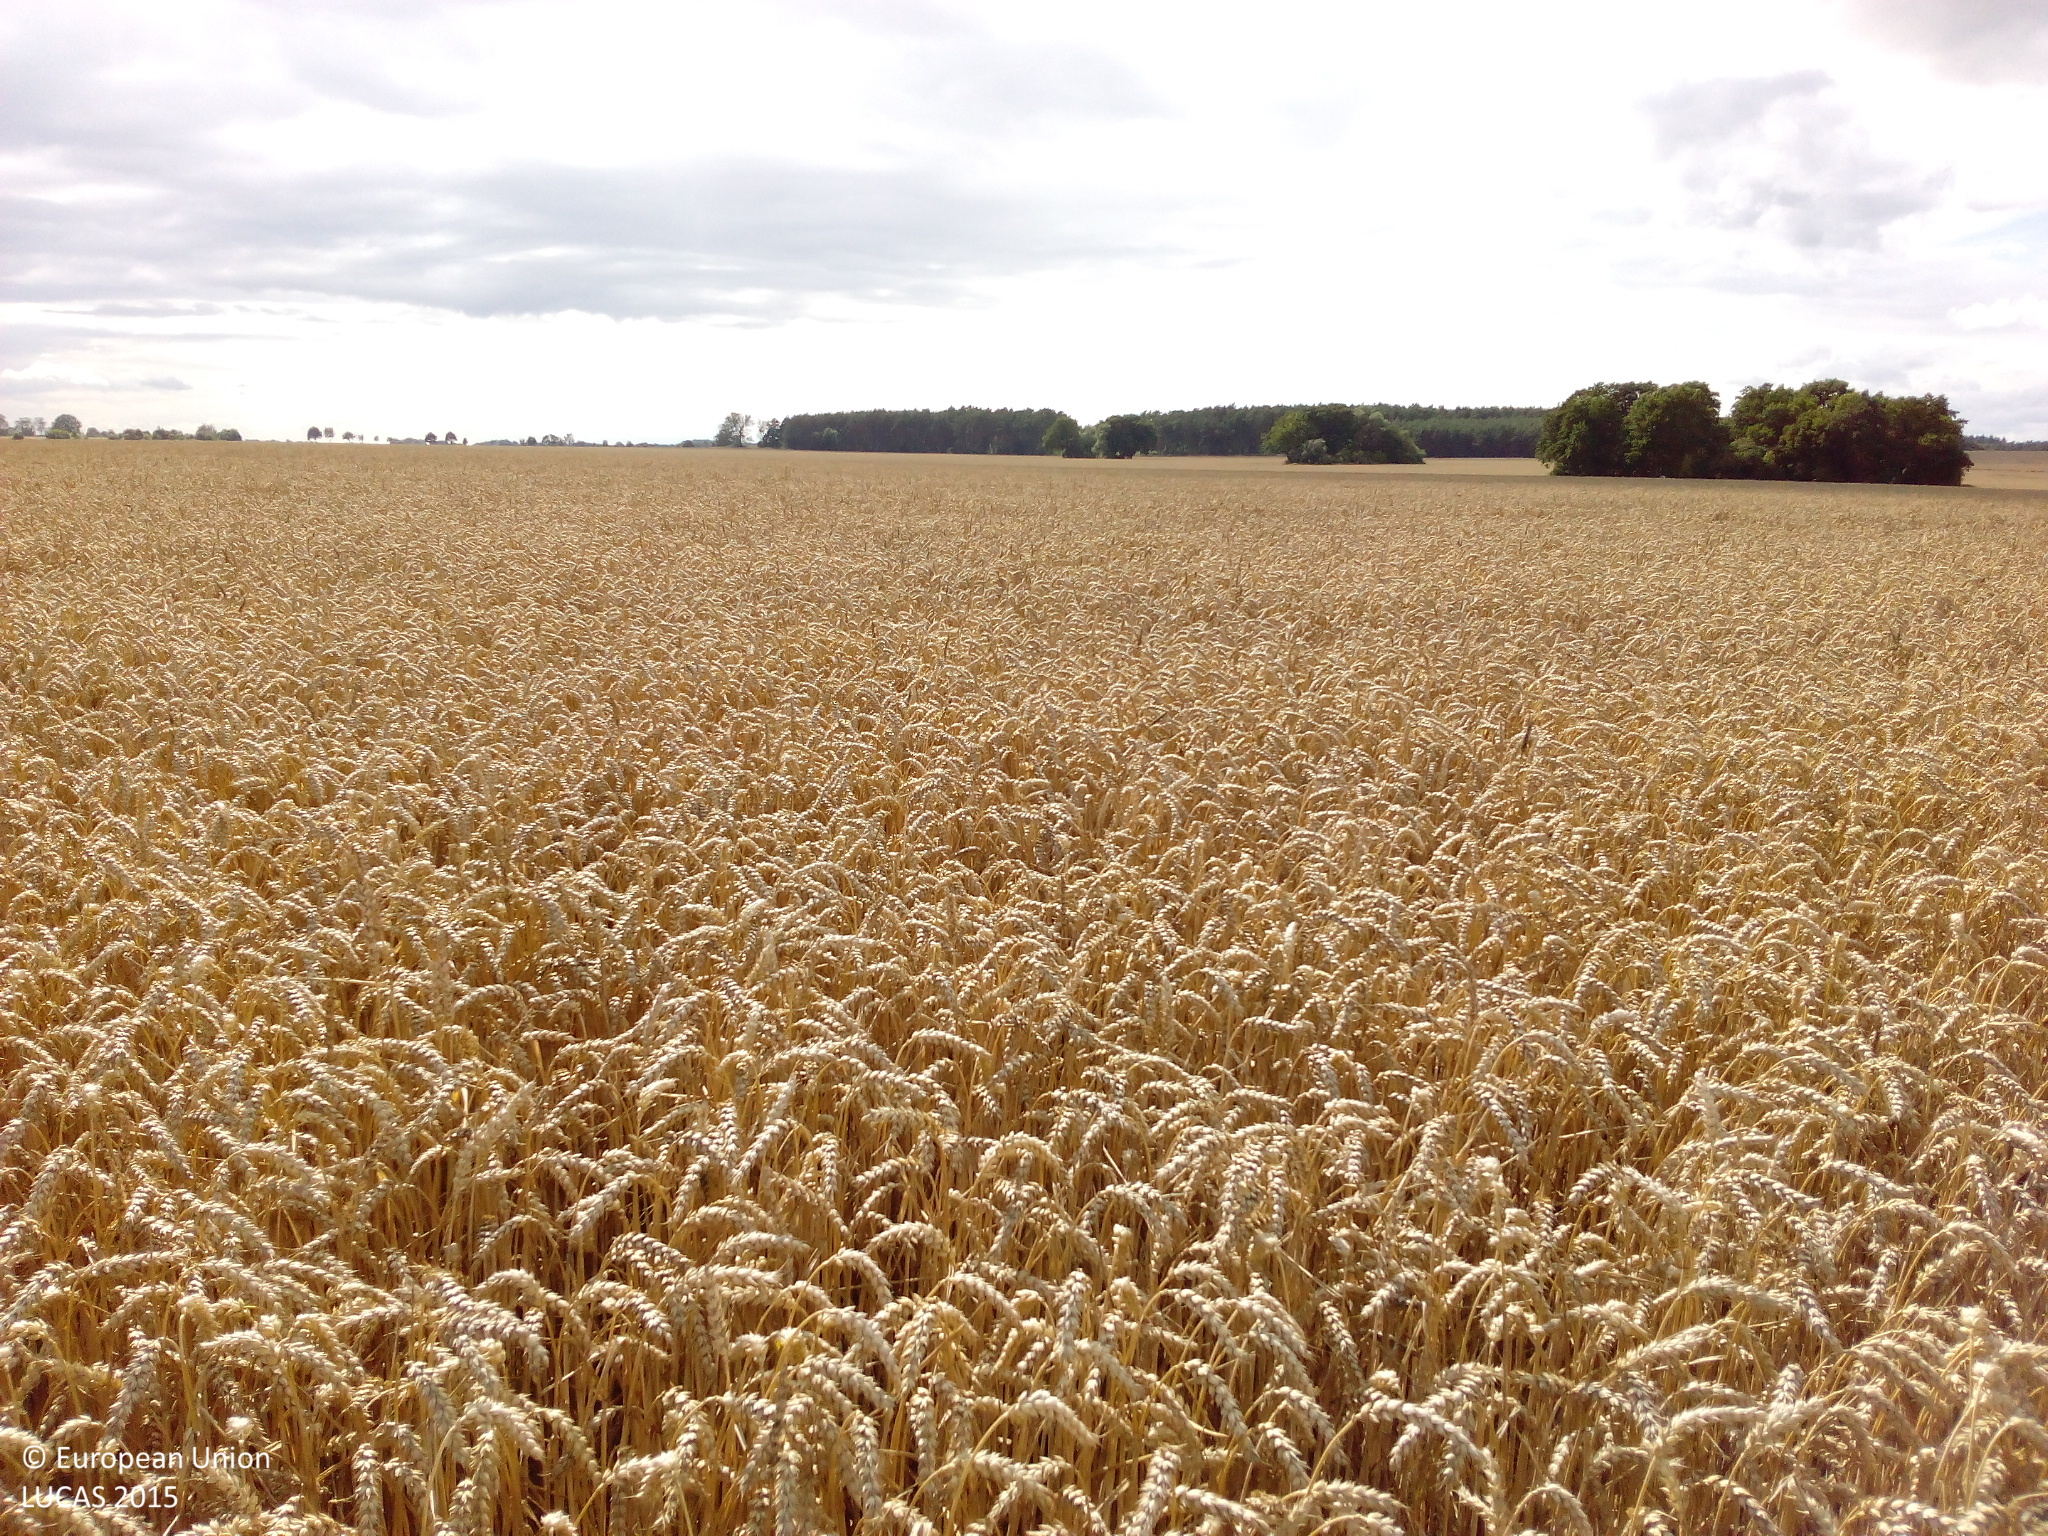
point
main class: Cropland
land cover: Common wheat
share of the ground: > 75 %
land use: Agriculture (excluding fallow land and kitchen gardens)
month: July
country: DE
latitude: 53.1752
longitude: 11.6302
